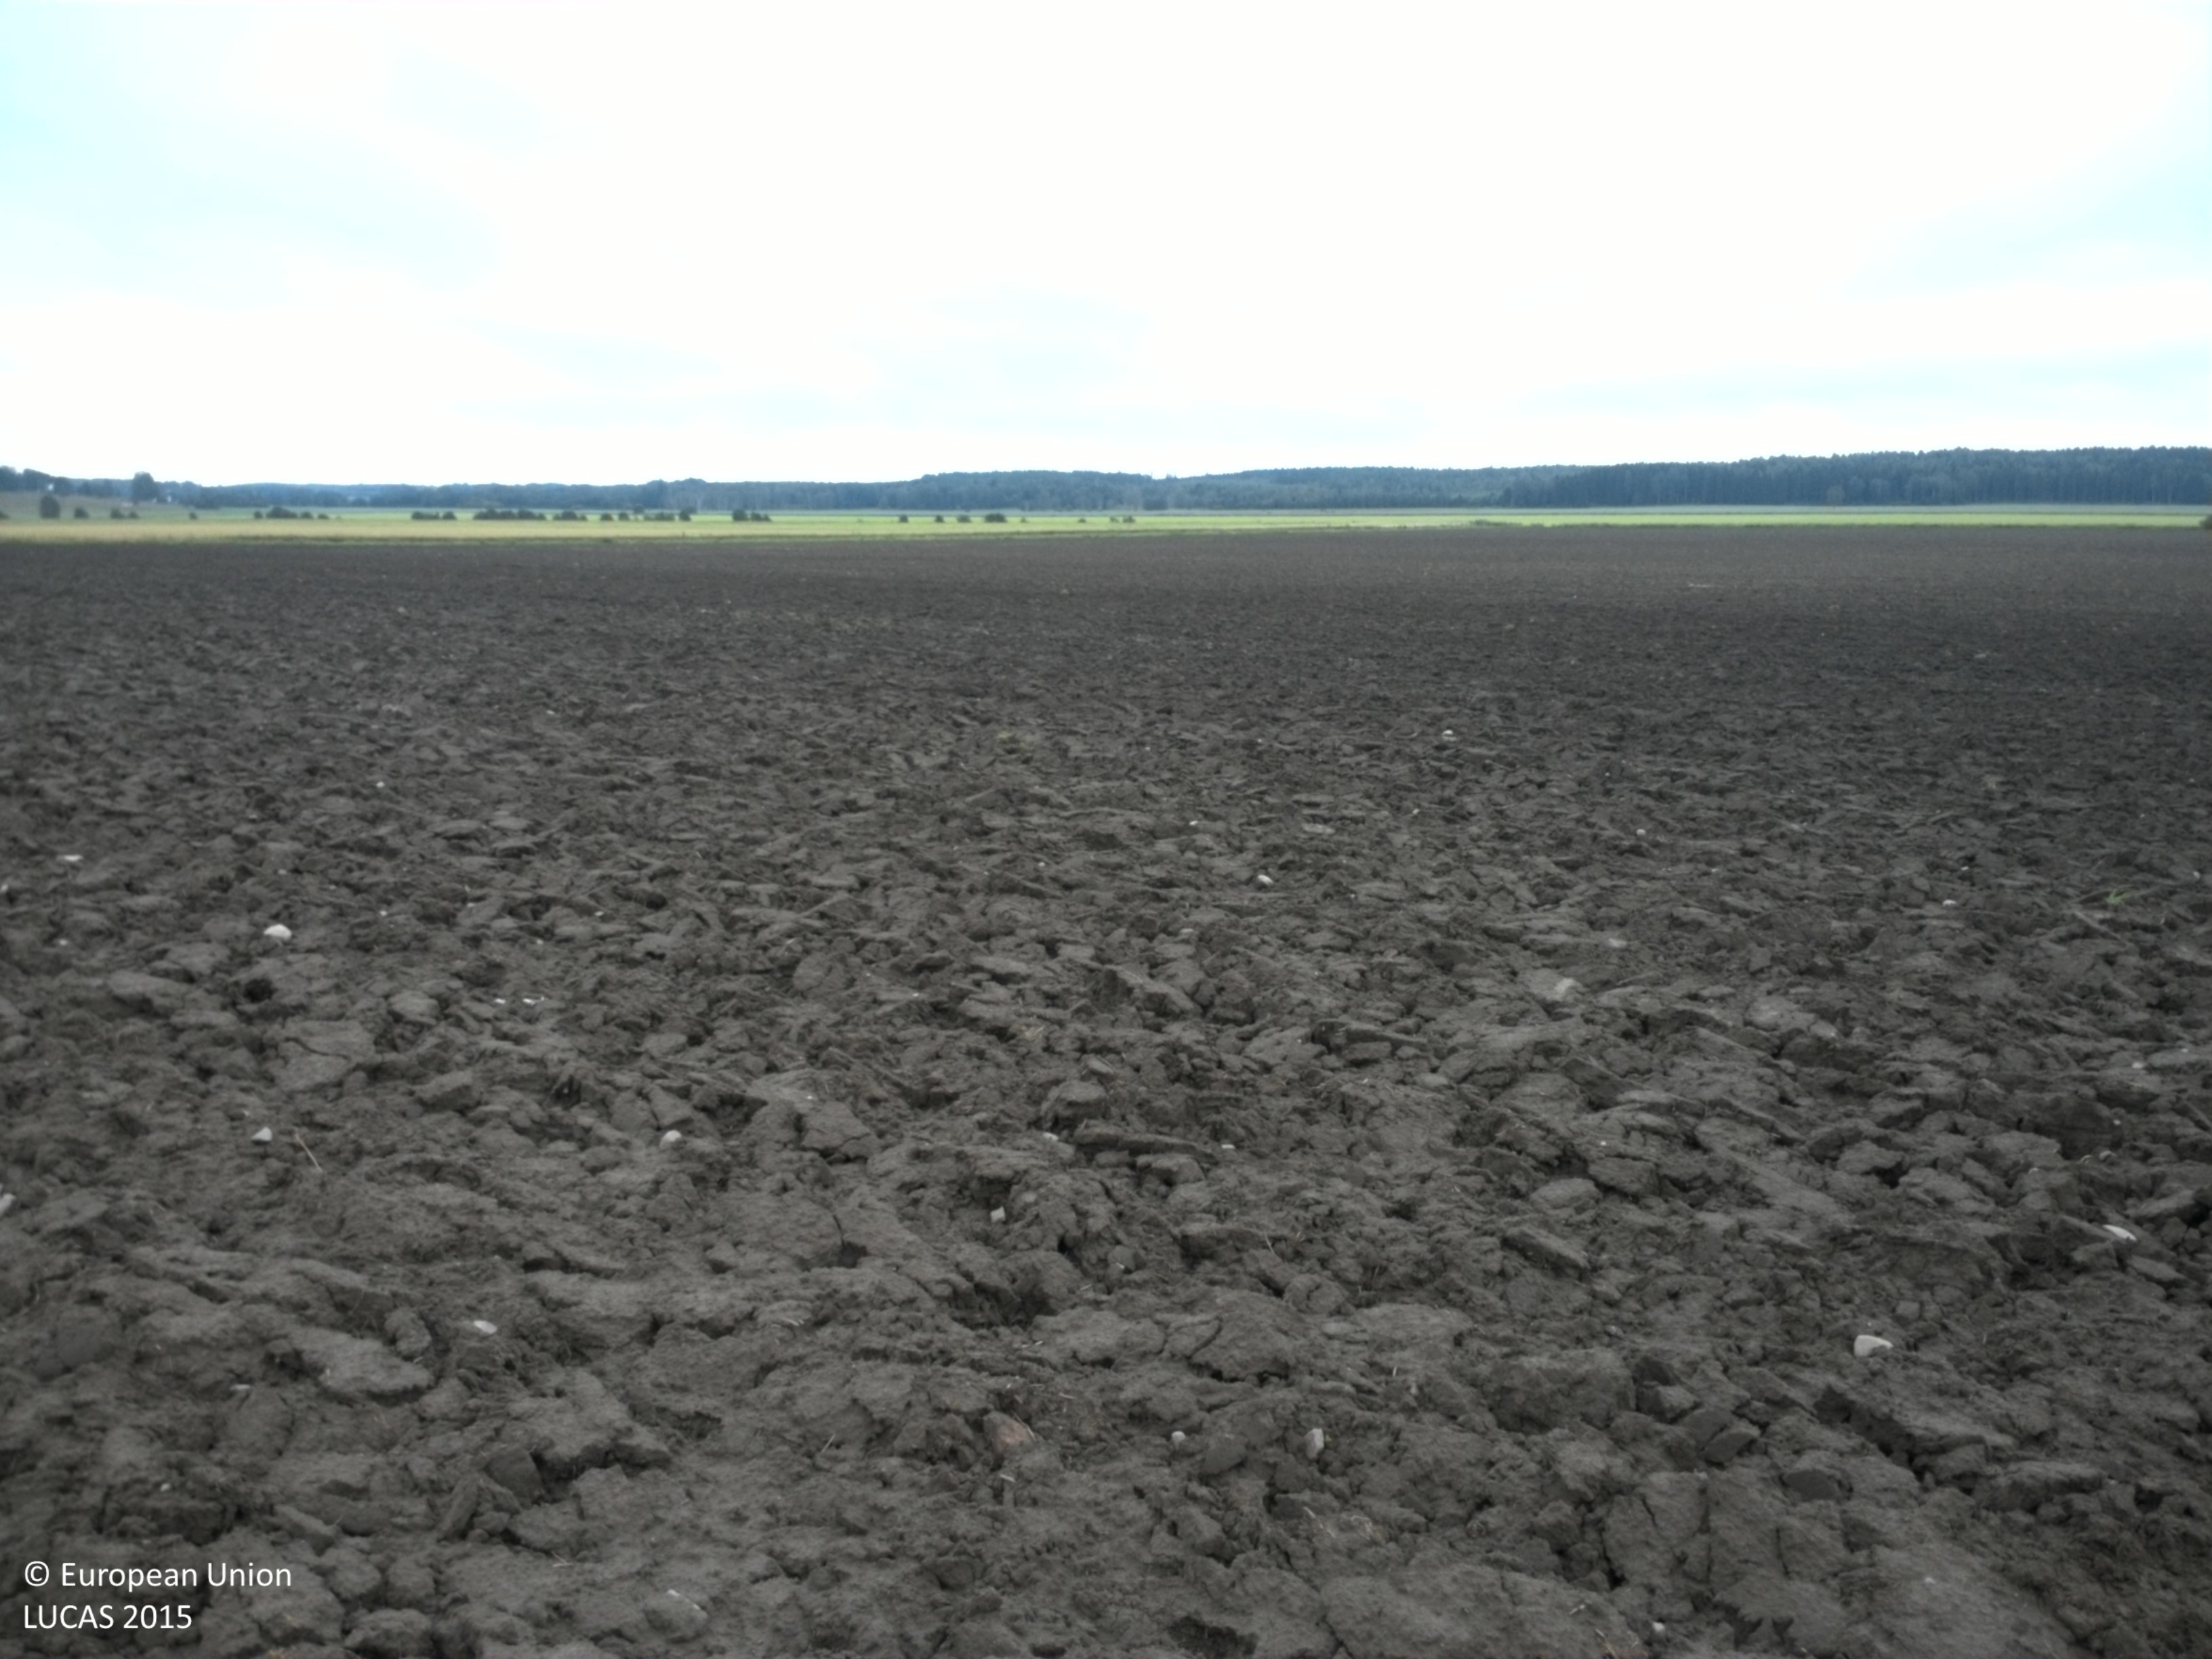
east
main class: Cropland
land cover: Other leguminous and mixtures for fodder
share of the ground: > 75 %
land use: Agriculture (excluding fallow land and kitchen gardens)
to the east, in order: Other leguminous and mixtures for fodder; Other bare soil
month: July
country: SE
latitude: 59.4226
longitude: 13.2528
